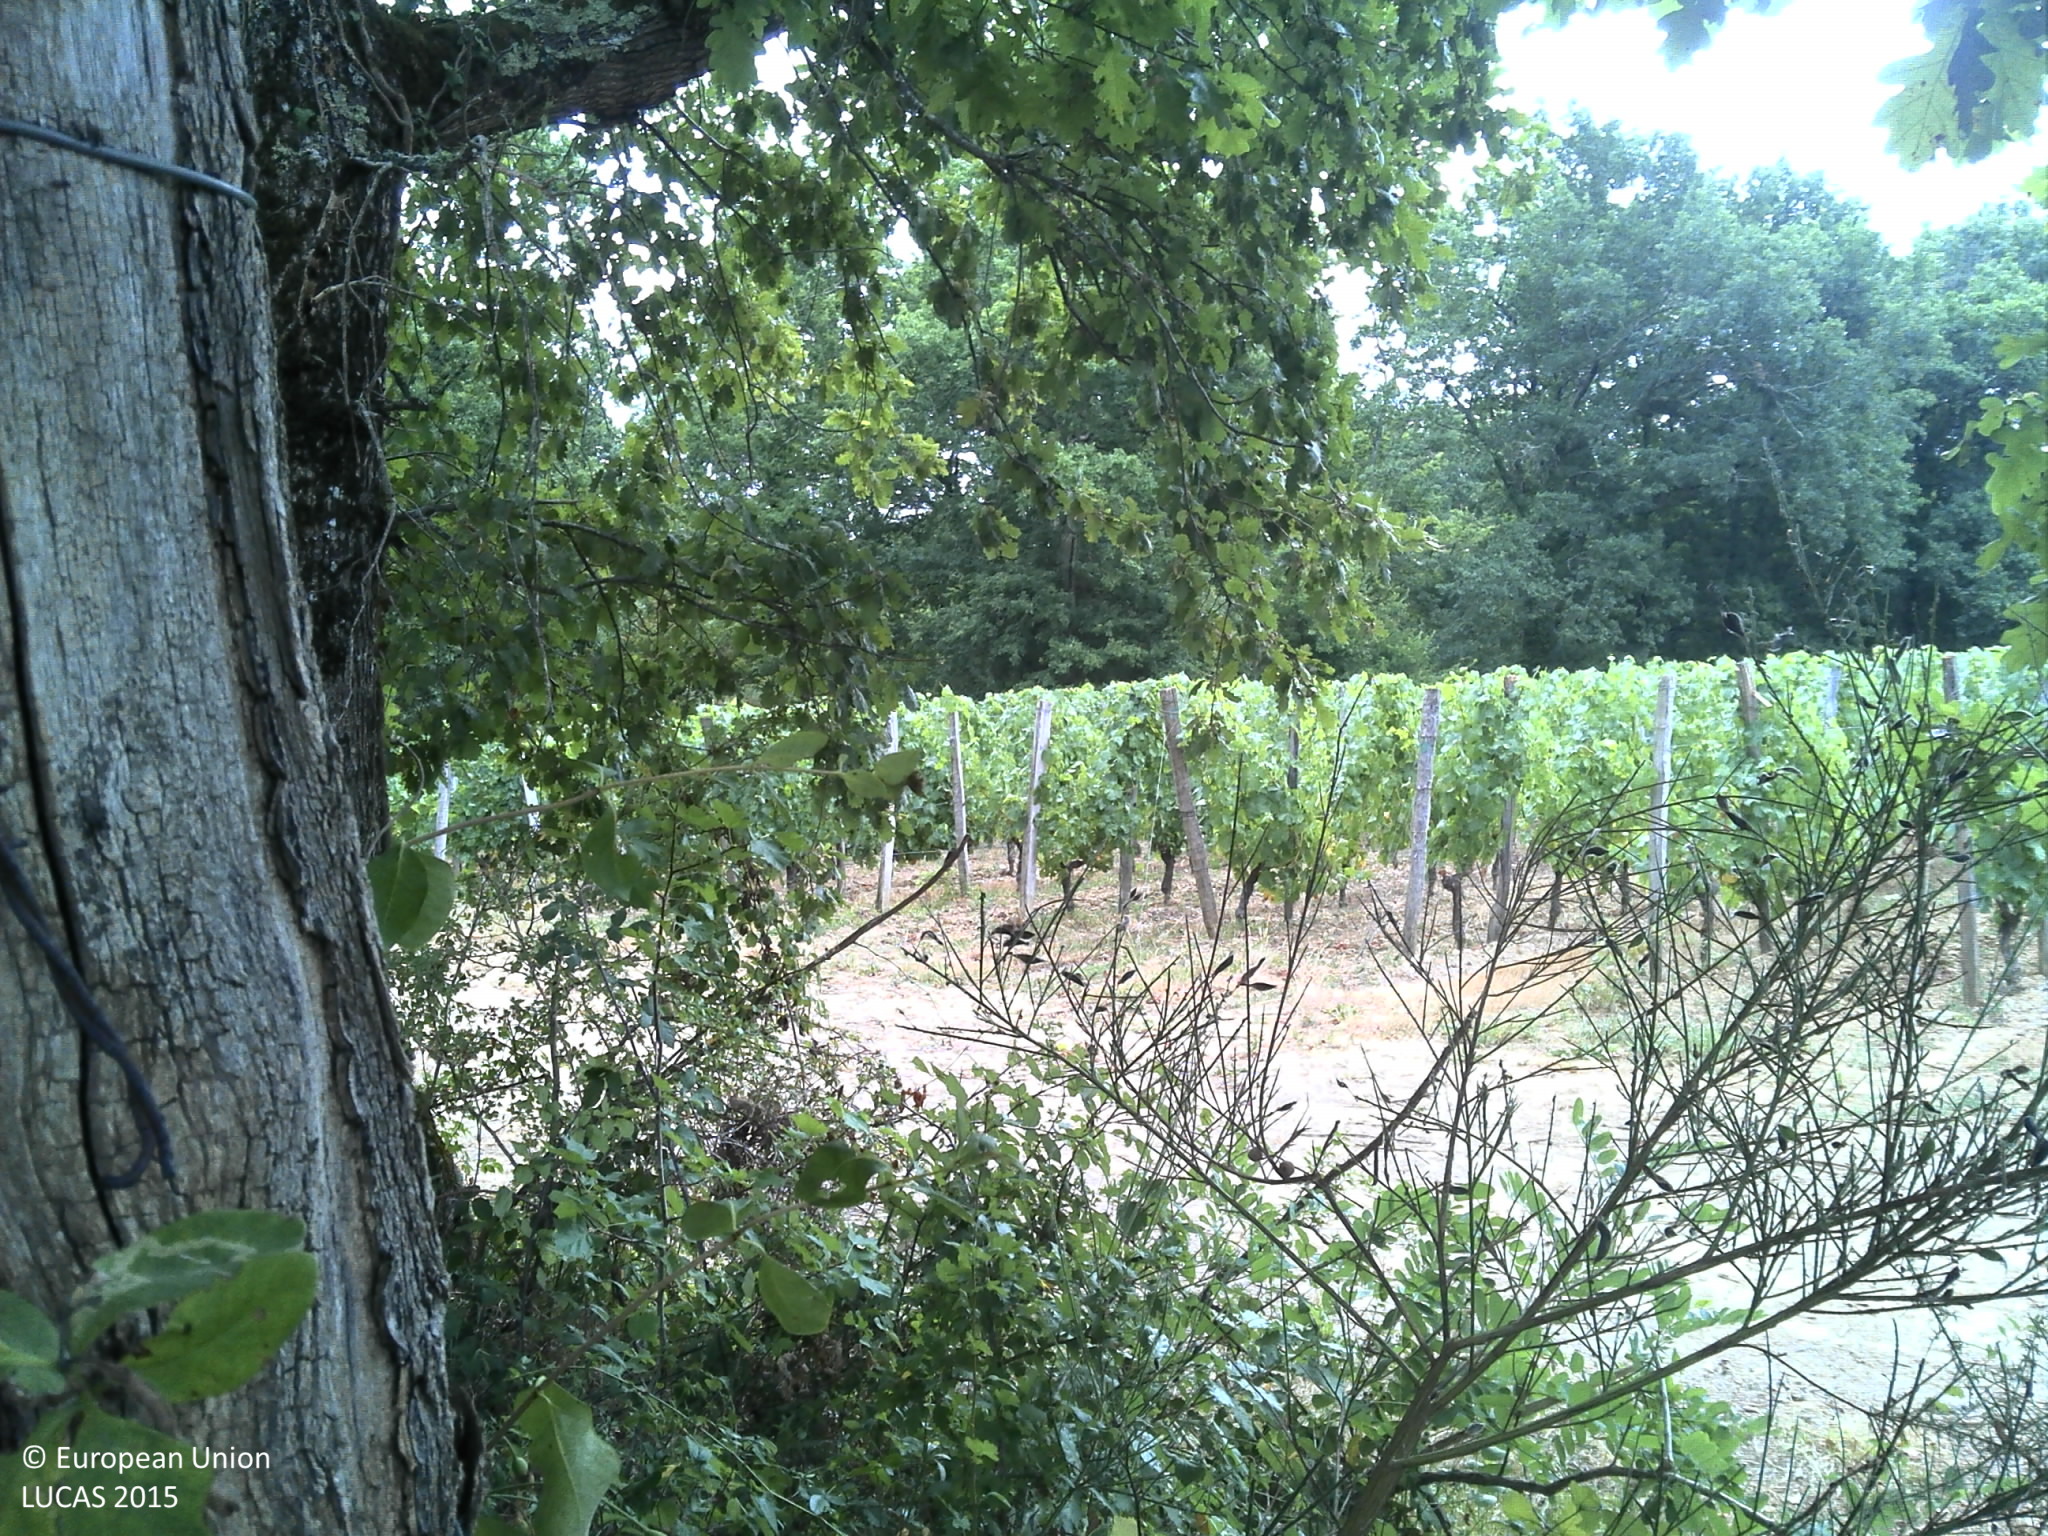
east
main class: Woodland
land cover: Broadleaved woodland
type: thermophilous deciduous forest
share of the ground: > 75 %
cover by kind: broadleaved forest trees 100 %
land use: Forestry
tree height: > 5 m
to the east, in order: Broadleaved woodland; Grassland without tree/shrub cover; Broadleaved woodland; Tracks; Vineyards
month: July
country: FR
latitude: 44.8055
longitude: -0.4222
